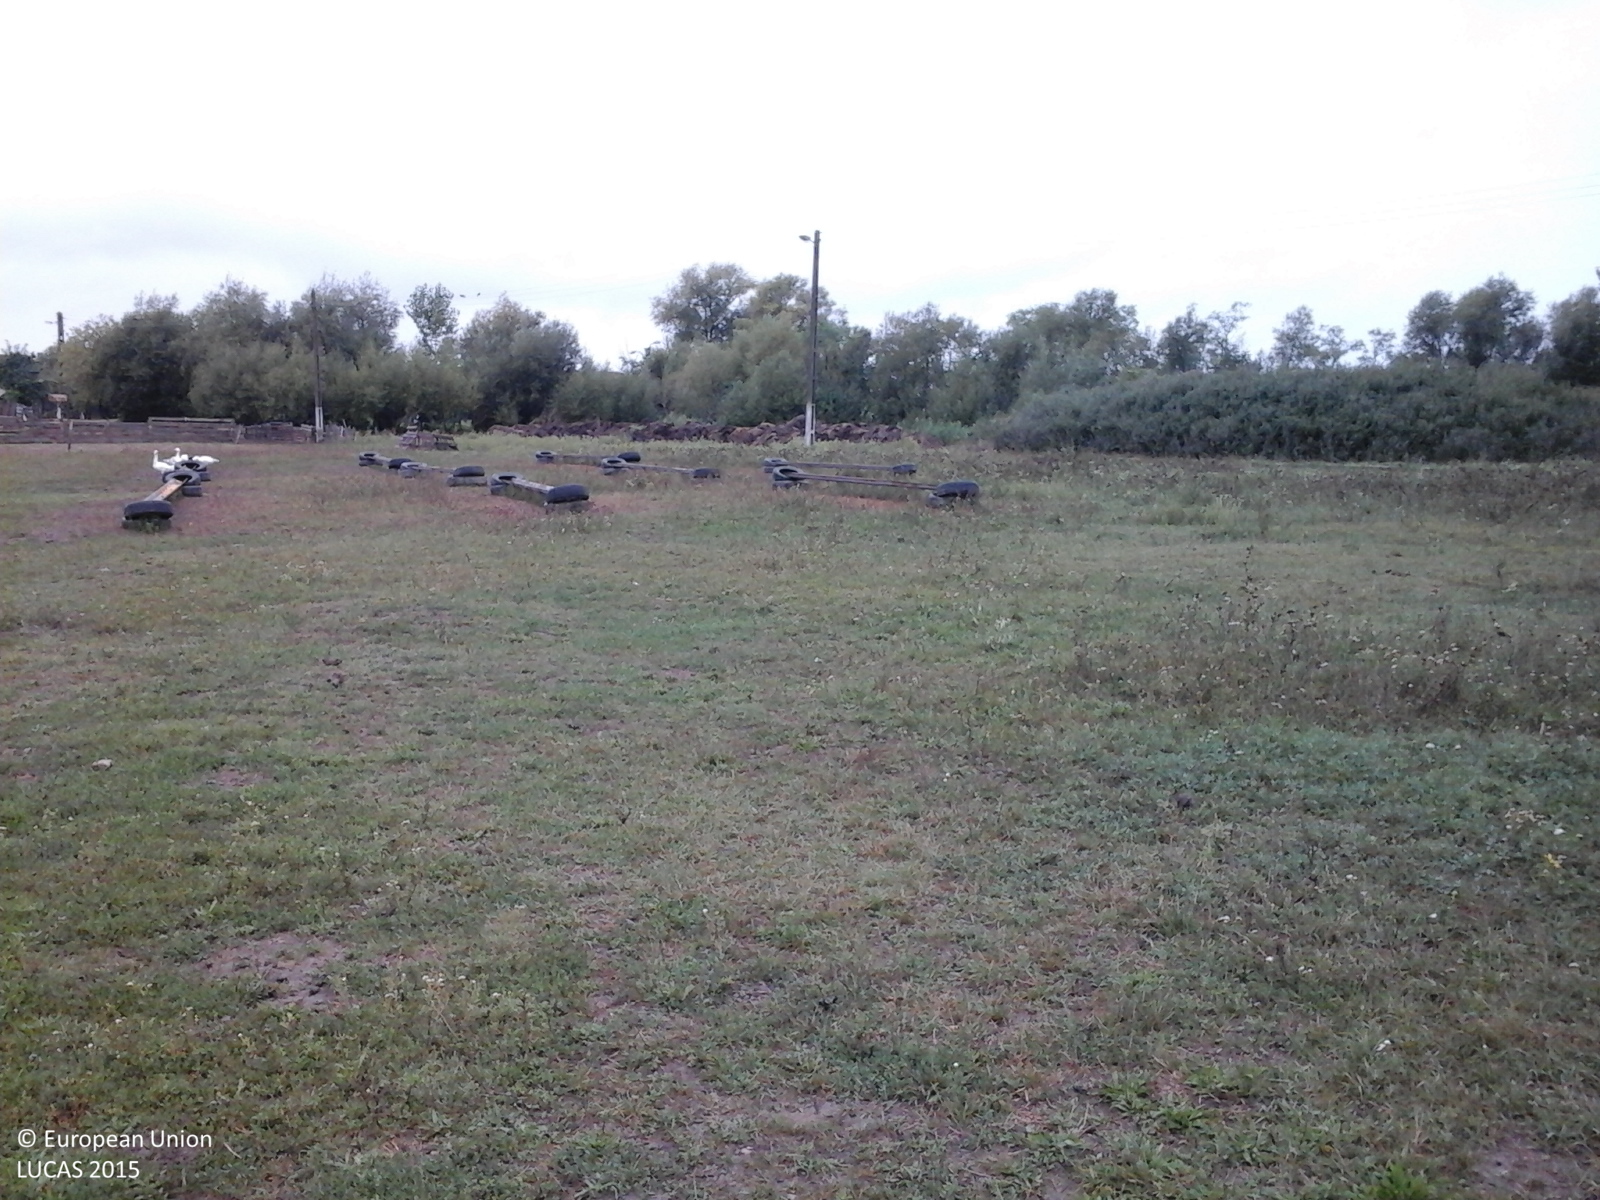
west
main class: Grassland
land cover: Grassland without tree/shrub cover
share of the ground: > 75 %
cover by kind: herbaceous plants 100 %
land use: Agriculture (excluding fallow land and kitchen gardens)
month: September
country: RO
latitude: 46.8758
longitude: 21.6536
